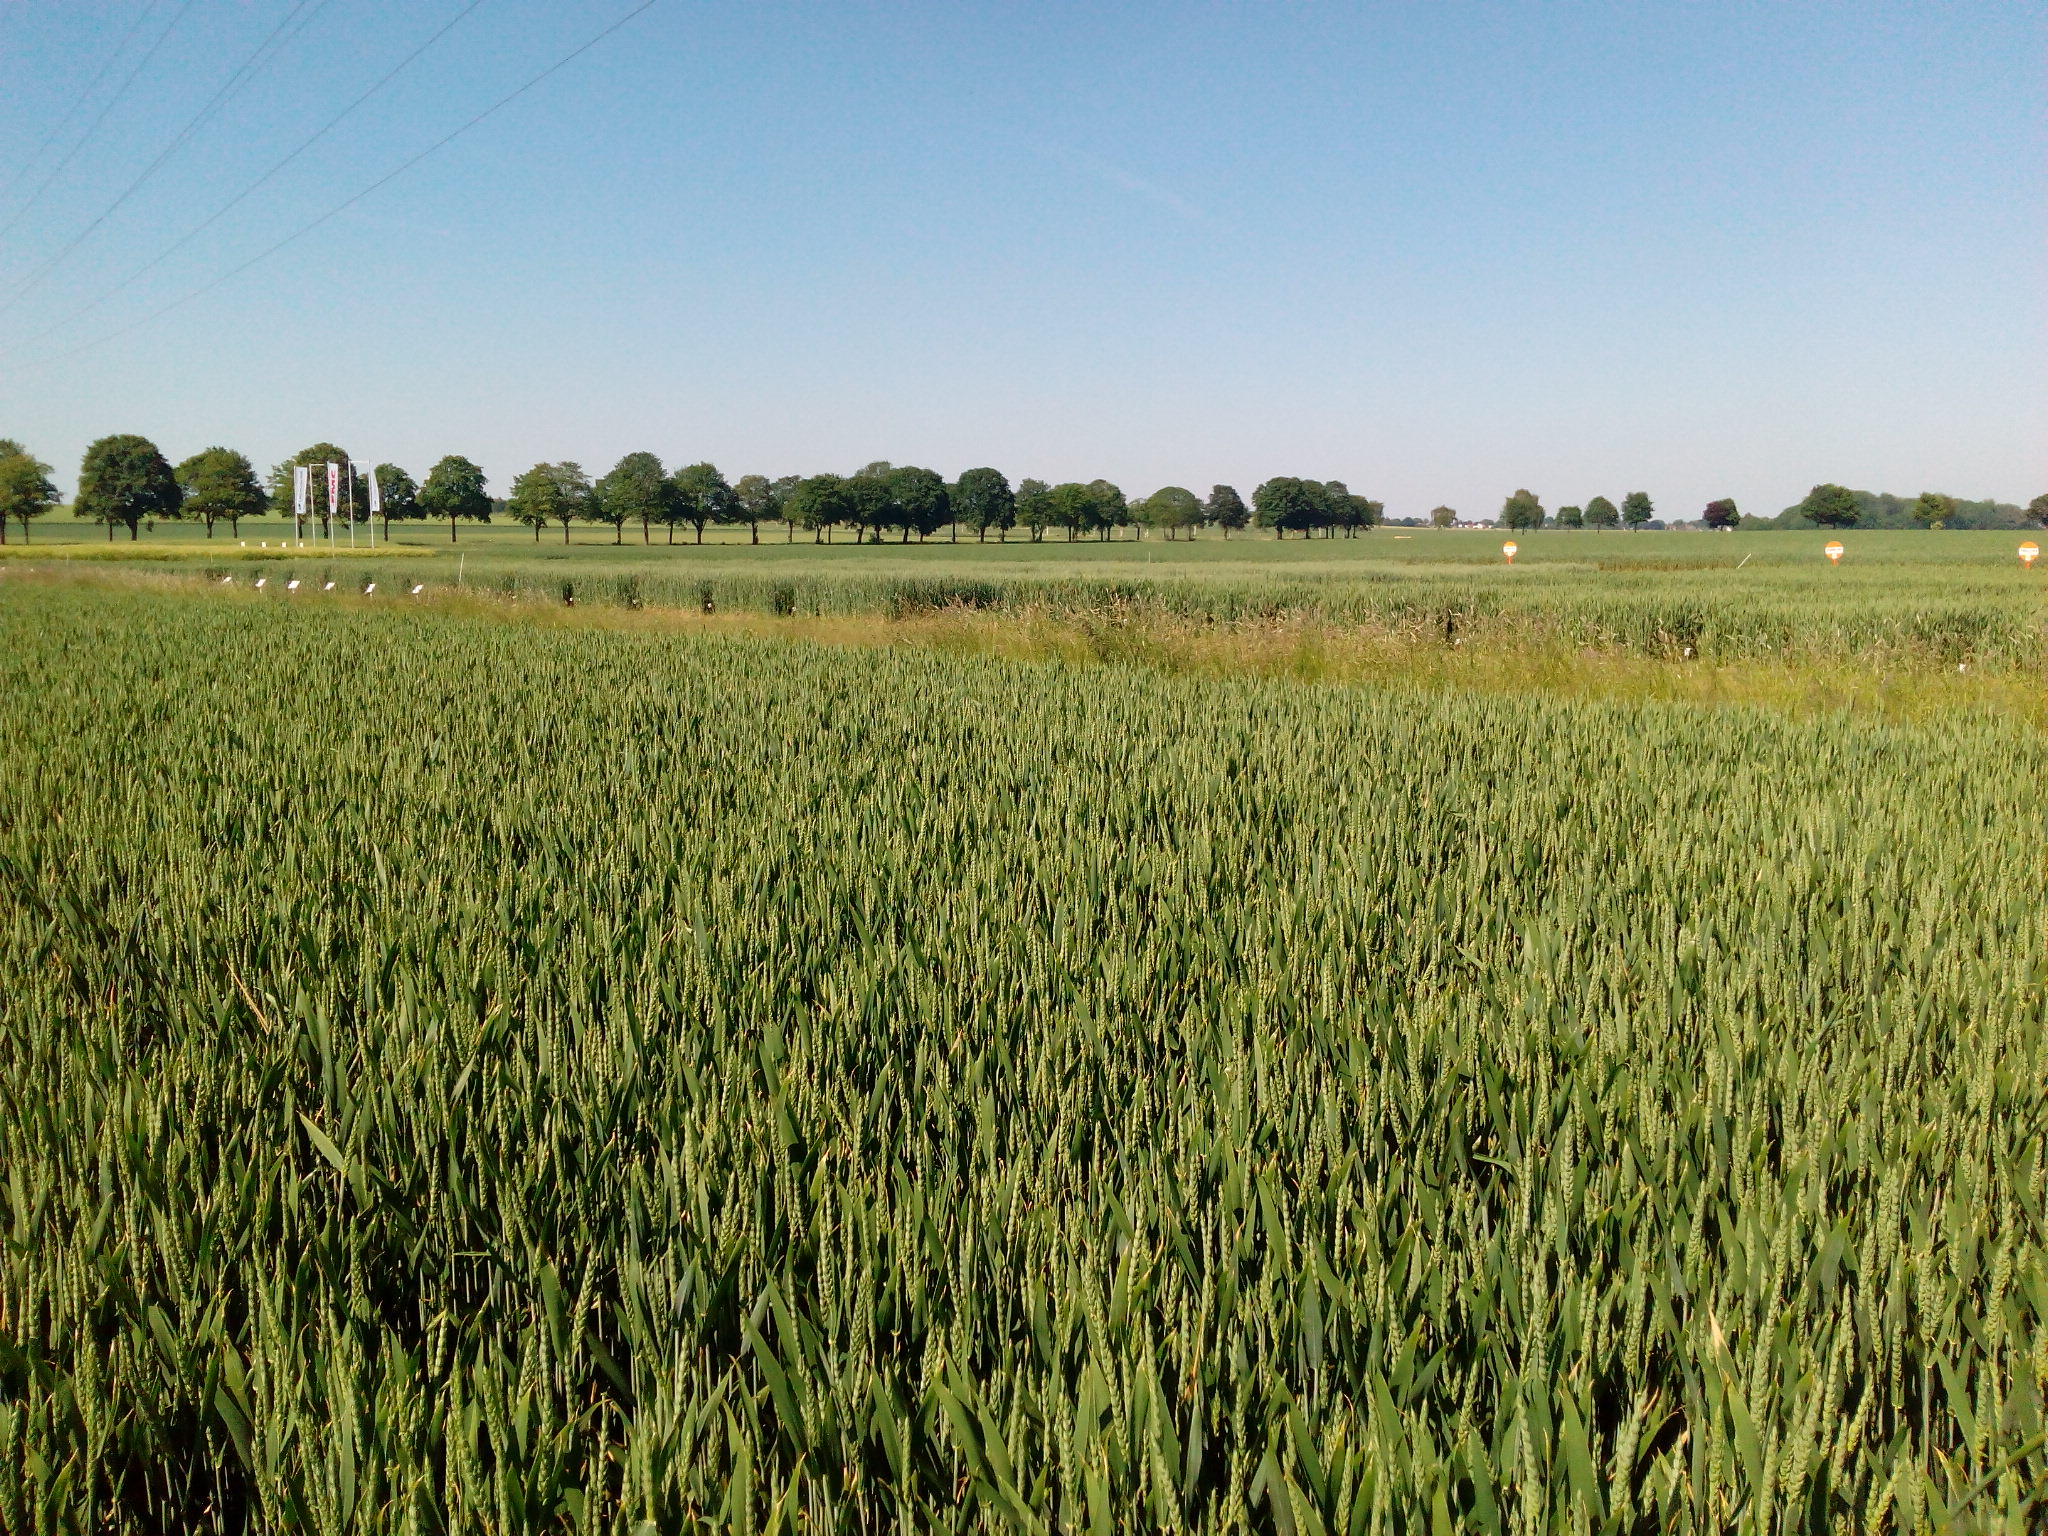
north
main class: Cropland
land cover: Common wheat
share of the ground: > 75 %
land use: Agriculture (excluding fallow land and kitchen gardens)
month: June
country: DE
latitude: 52.2516
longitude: 9.9268
